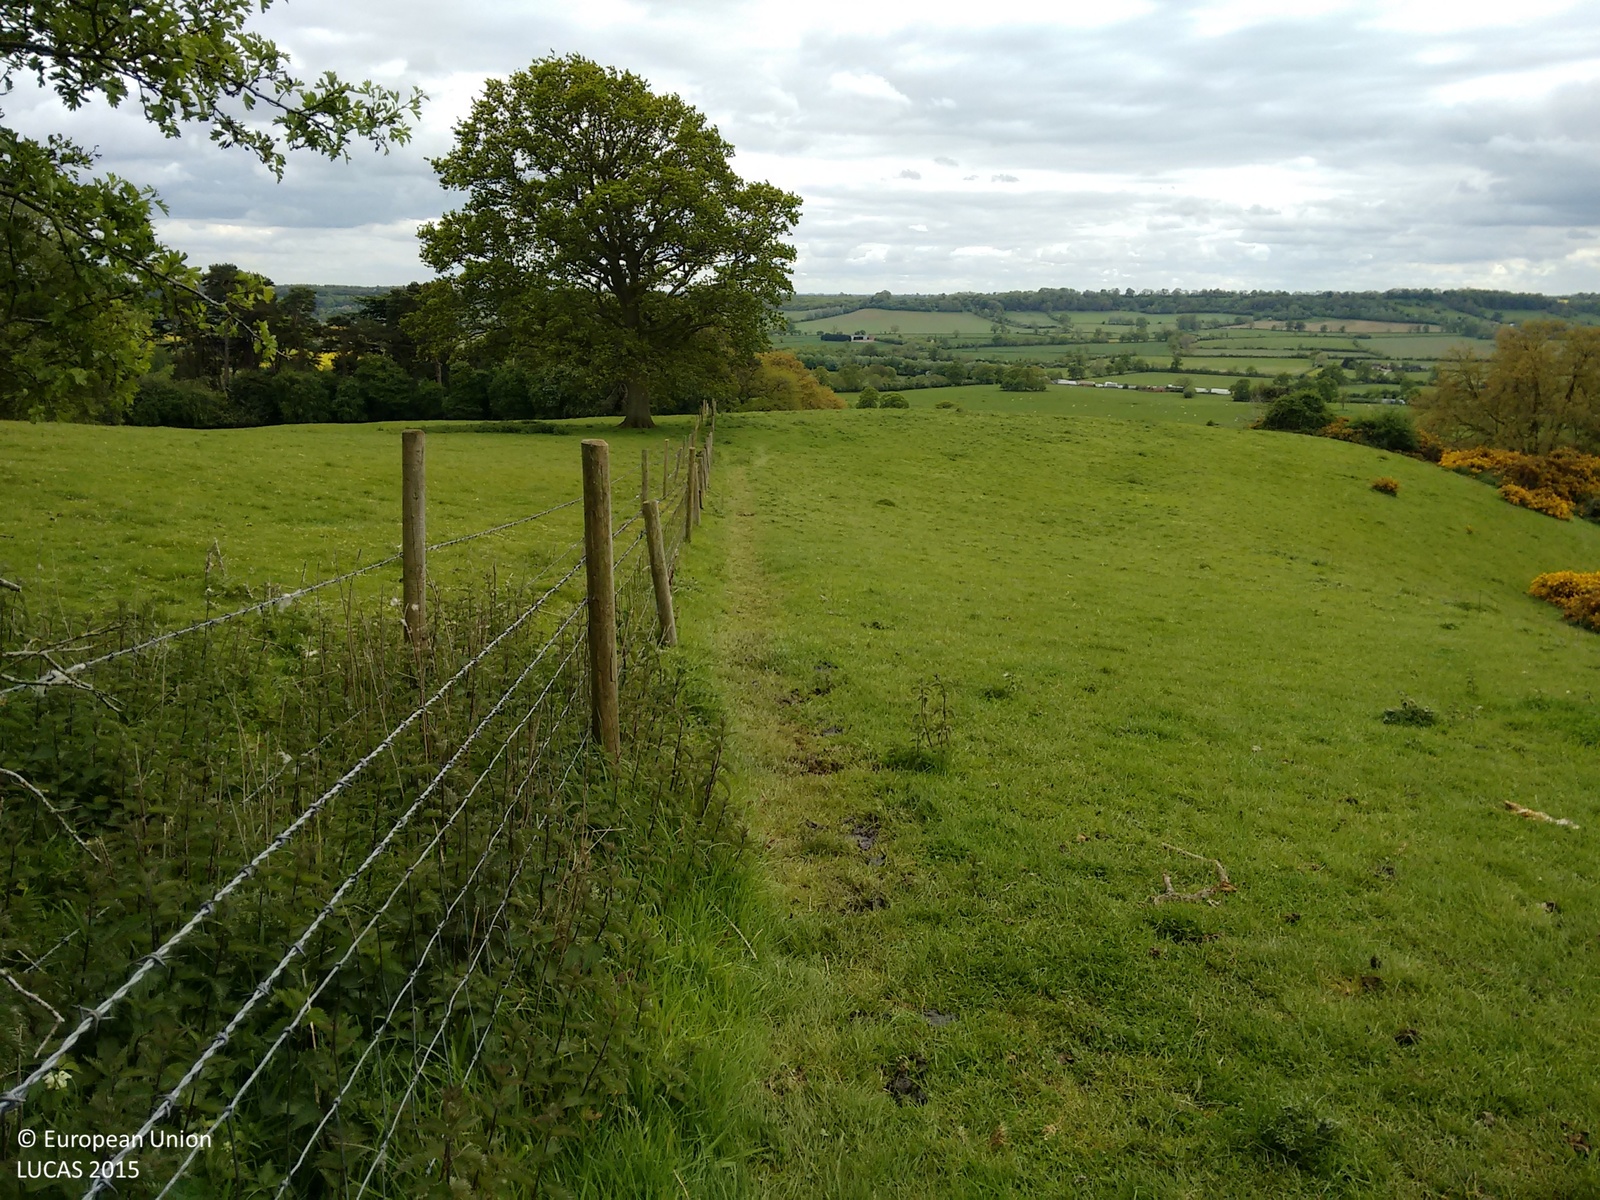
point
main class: Grassland
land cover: Grassland without tree/shrub cover
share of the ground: > 75 %
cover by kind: herbaceous plants 100 %
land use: Agriculture (excluding fallow land and kitchen gardens)
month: May
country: GB
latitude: 52.1526
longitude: -1.4061
